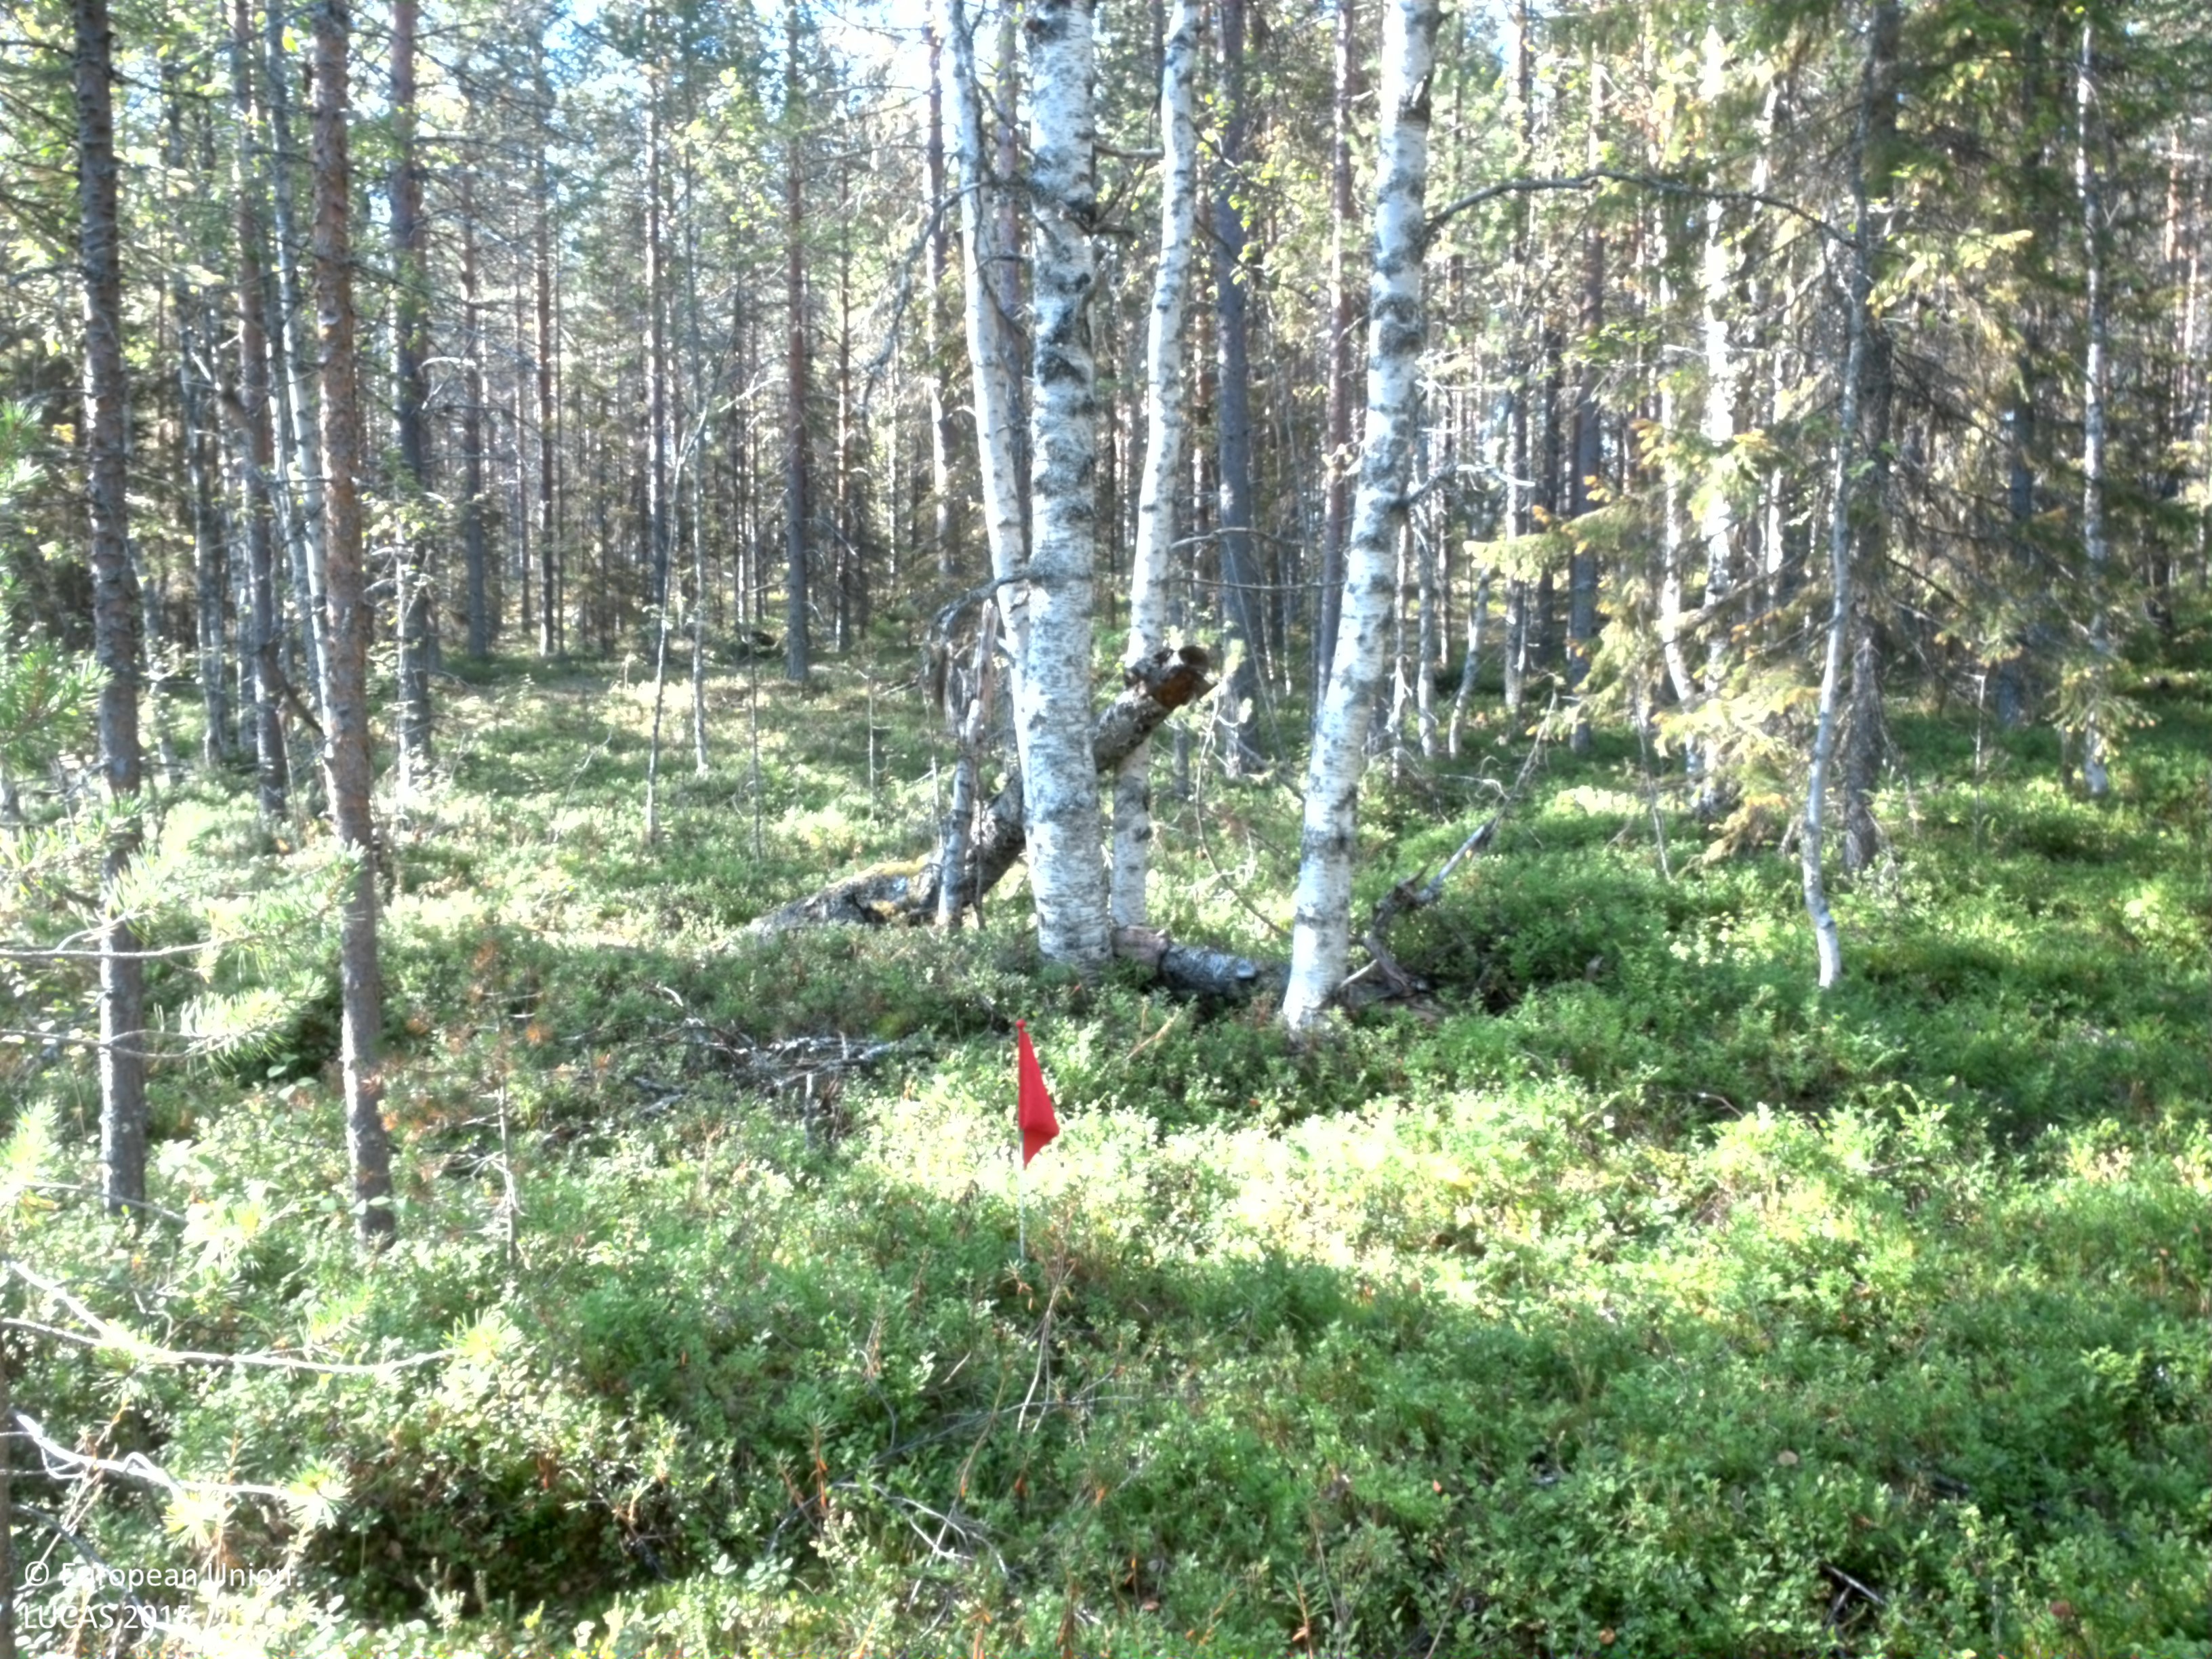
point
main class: Woodland
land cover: Pine dominated mixed woodland
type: boreal forest
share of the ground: 50 - 75 %
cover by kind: coniferous forest trees 45 %, shrubs 35 %, broadleaved forest trees 15 %, lichens and mosses 5 %
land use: Forestry
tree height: > 5 m
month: August
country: SE
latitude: 64.5497
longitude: 18.8746
